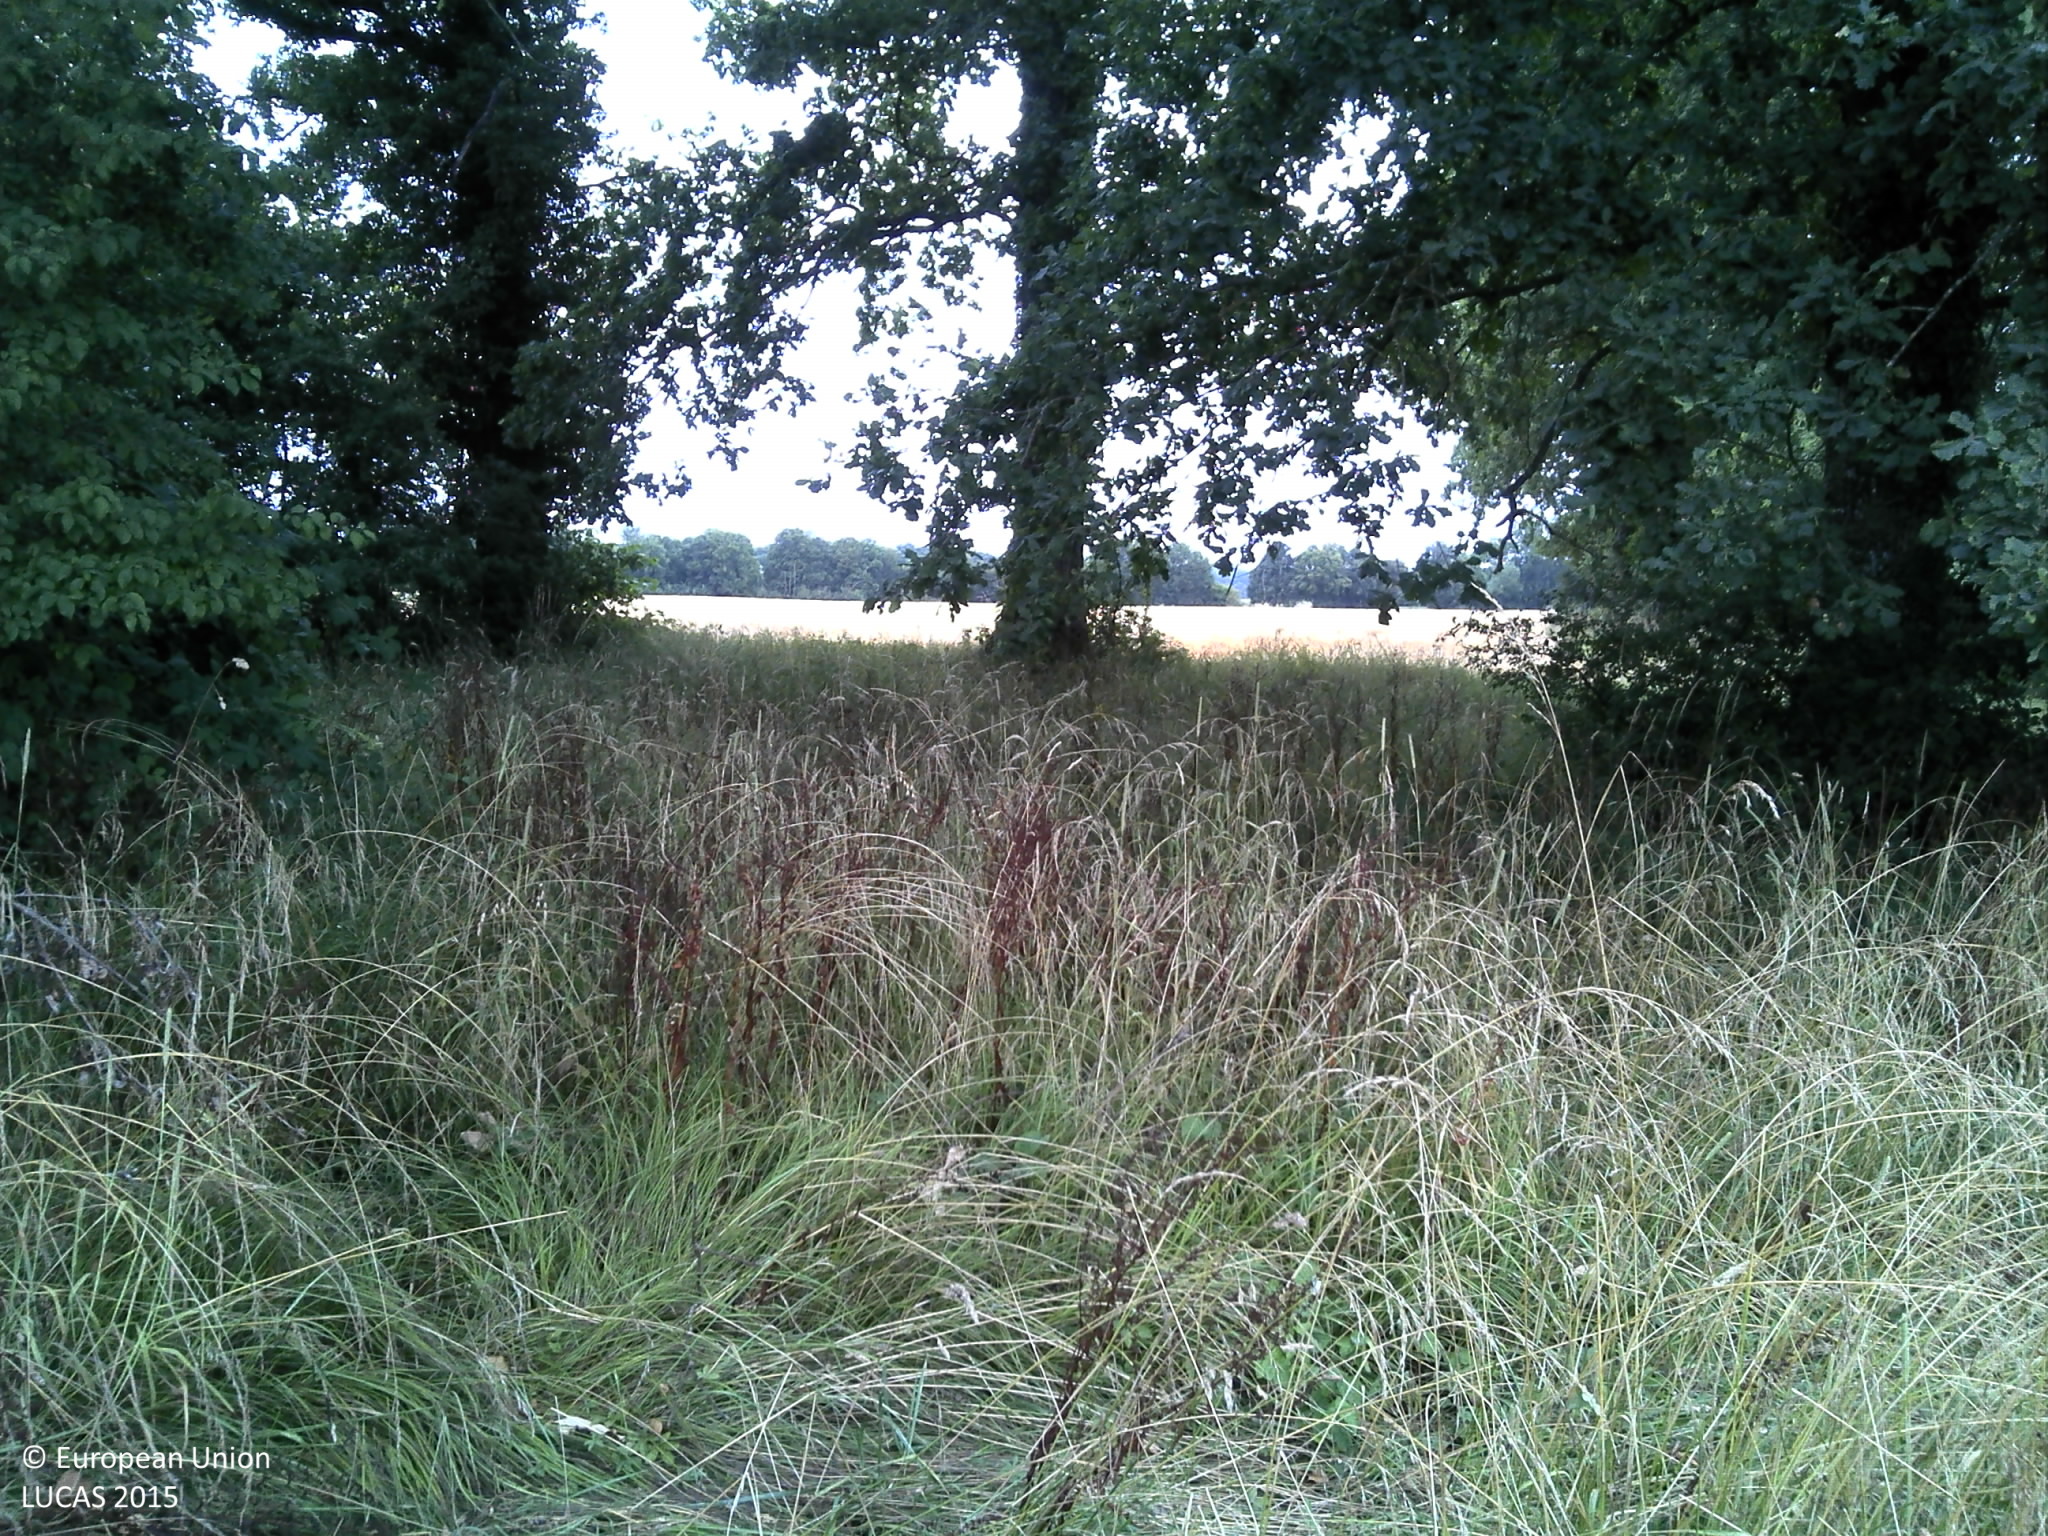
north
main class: Grassland
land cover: Grassland with sparse tree/shrub cover
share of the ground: > 75 %
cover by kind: herbaceous plants 95 %, broadleaved forest trees 5 %
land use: Agriculture (excluding fallow land and kitchen gardens)
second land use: Amenities, museums, leisure
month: July
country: FR
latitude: 48.5776
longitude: 4.5891
